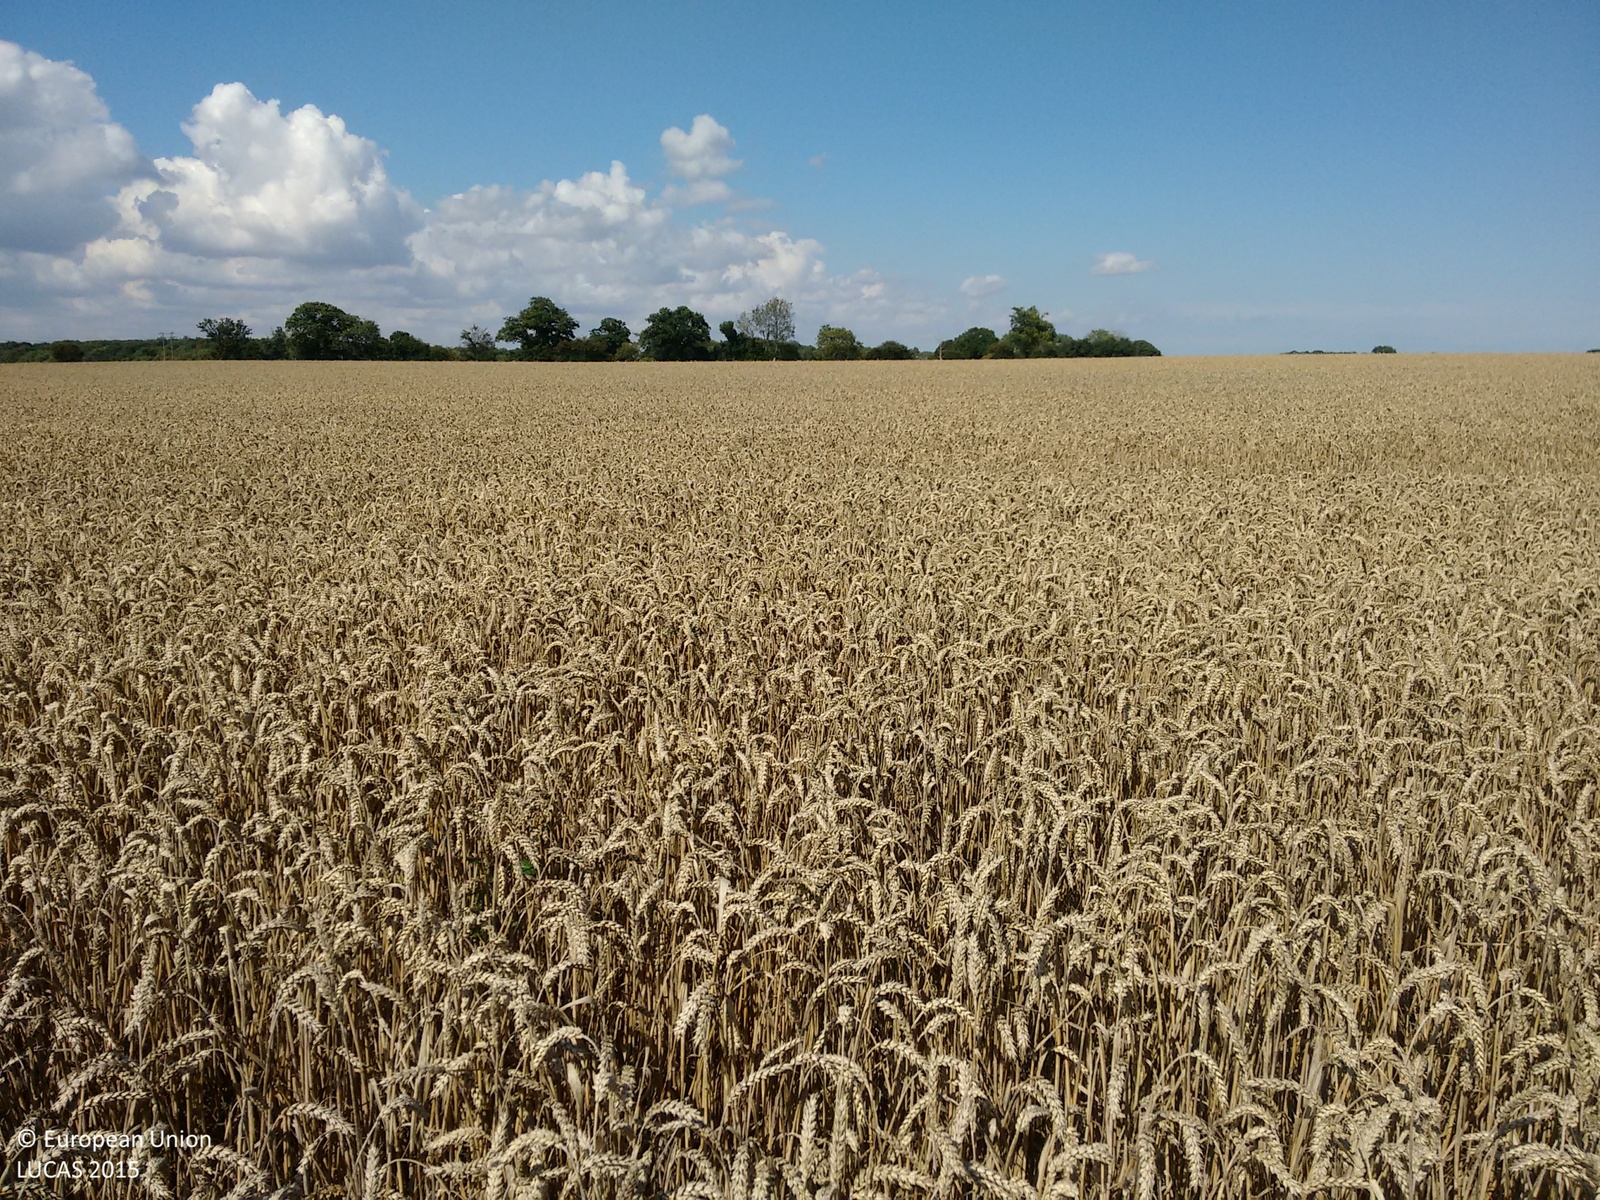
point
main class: Cropland
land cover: Common wheat
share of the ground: > 75 %
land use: Agriculture (excluding fallow land and kitchen gardens)
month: August
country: GB
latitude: 52.1397
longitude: 1.4326
